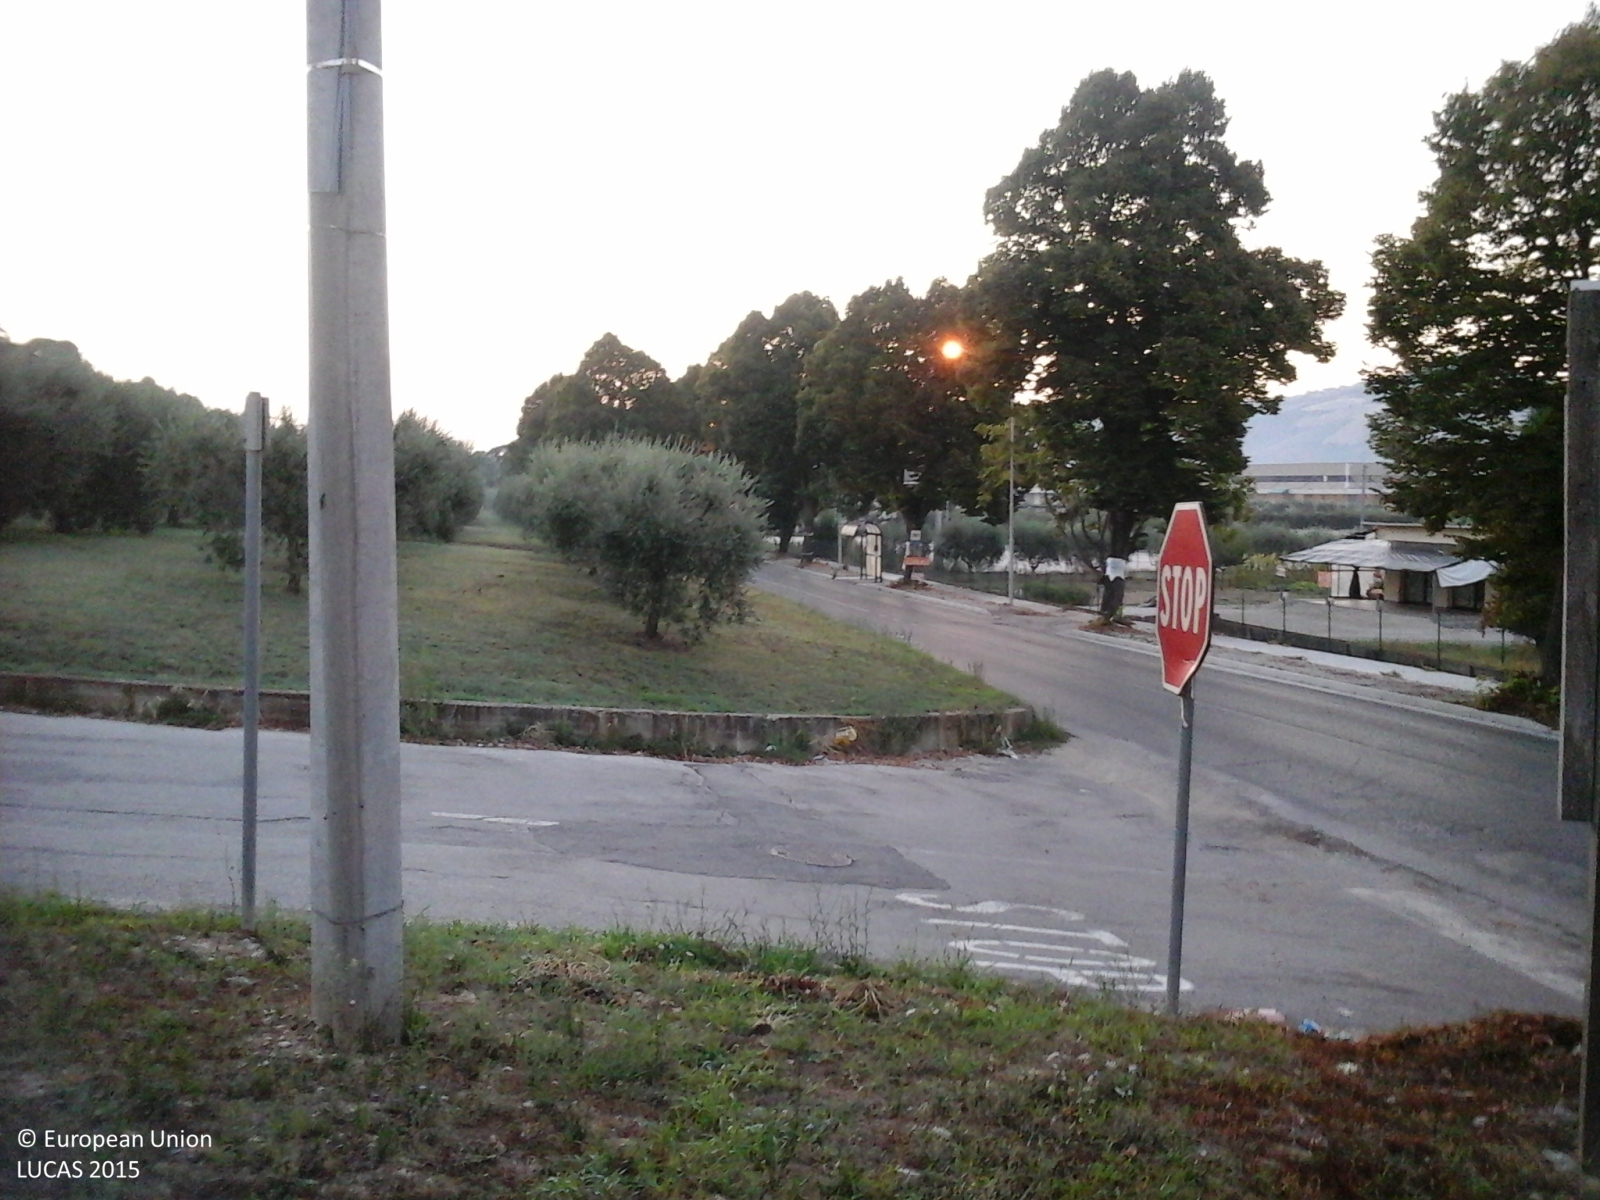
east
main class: Grassland
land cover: Spontaneously vegetated surfaces
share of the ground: > 75 %
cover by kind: herbaceous plants 90 %, unconsolidated bare surface 10 %
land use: Residential
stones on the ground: < 10 %
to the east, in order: Spontaneously vegetated surfaces; Electric lines; Paved roads, cycling and walking lanes; Olive groves; Lines of trees; Artificial constructions in urban areas
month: August
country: IT
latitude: 42.8892
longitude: 13.8221
